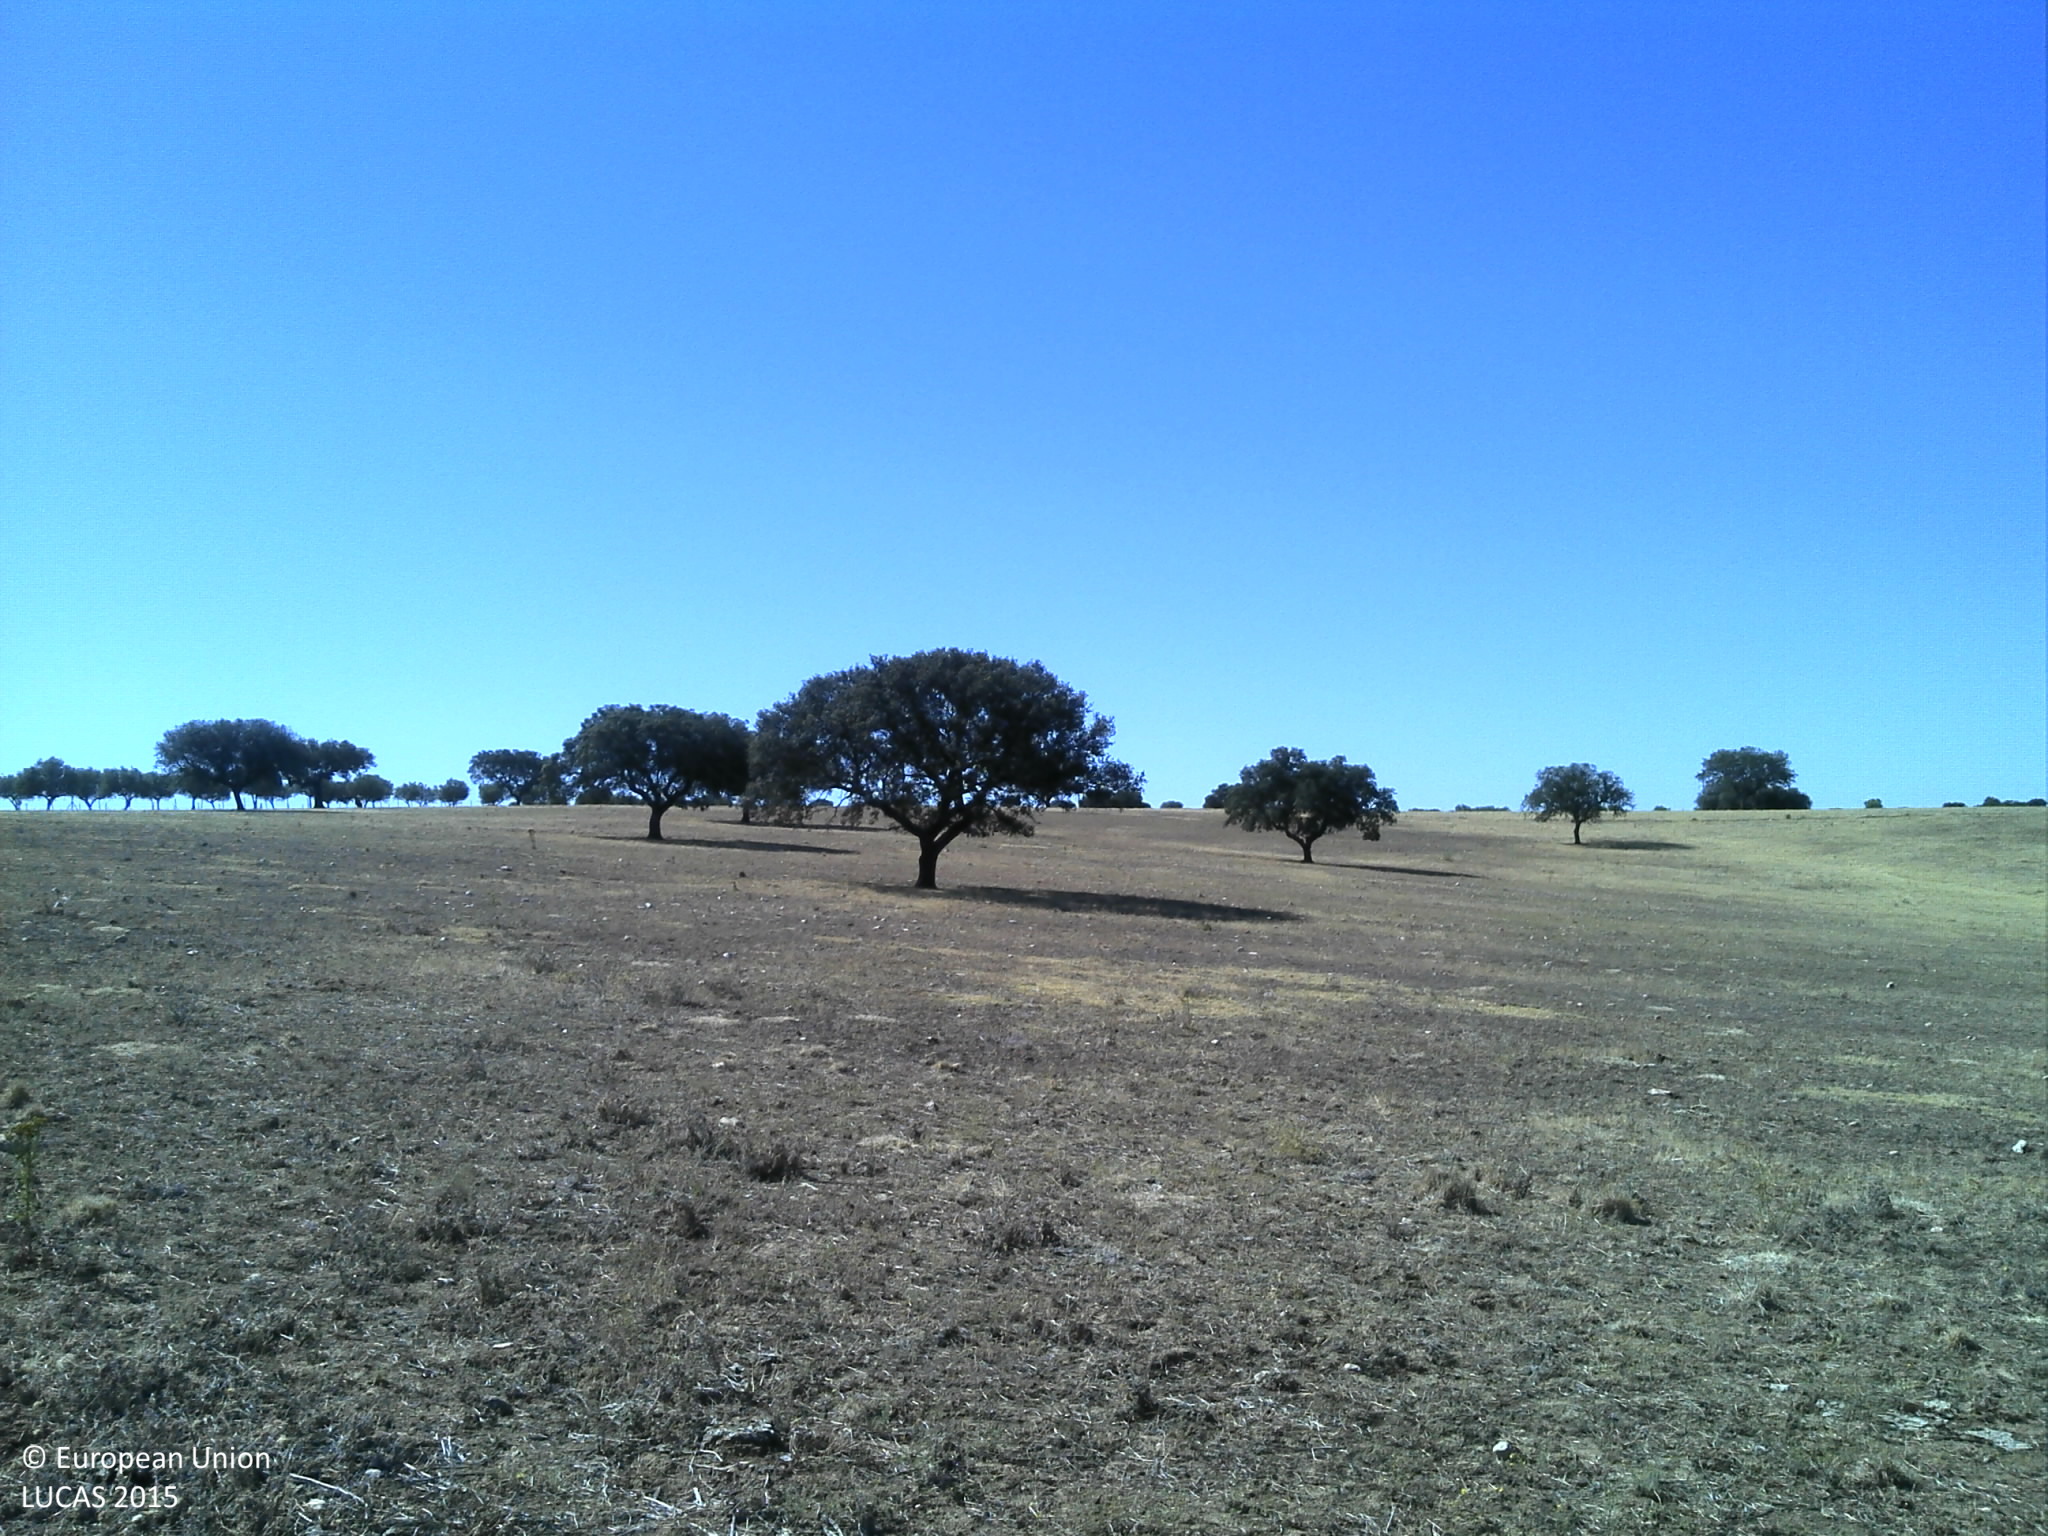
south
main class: Grassland
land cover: Grassland without tree/shrub cover
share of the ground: 10 - 25 %
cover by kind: unconsolidated bare surface 85 %, herbaceous plants 15 %
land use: Agriculture (excluding fallow land and kitchen gardens)
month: July
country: PT
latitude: 39.0765
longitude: -7.1503
